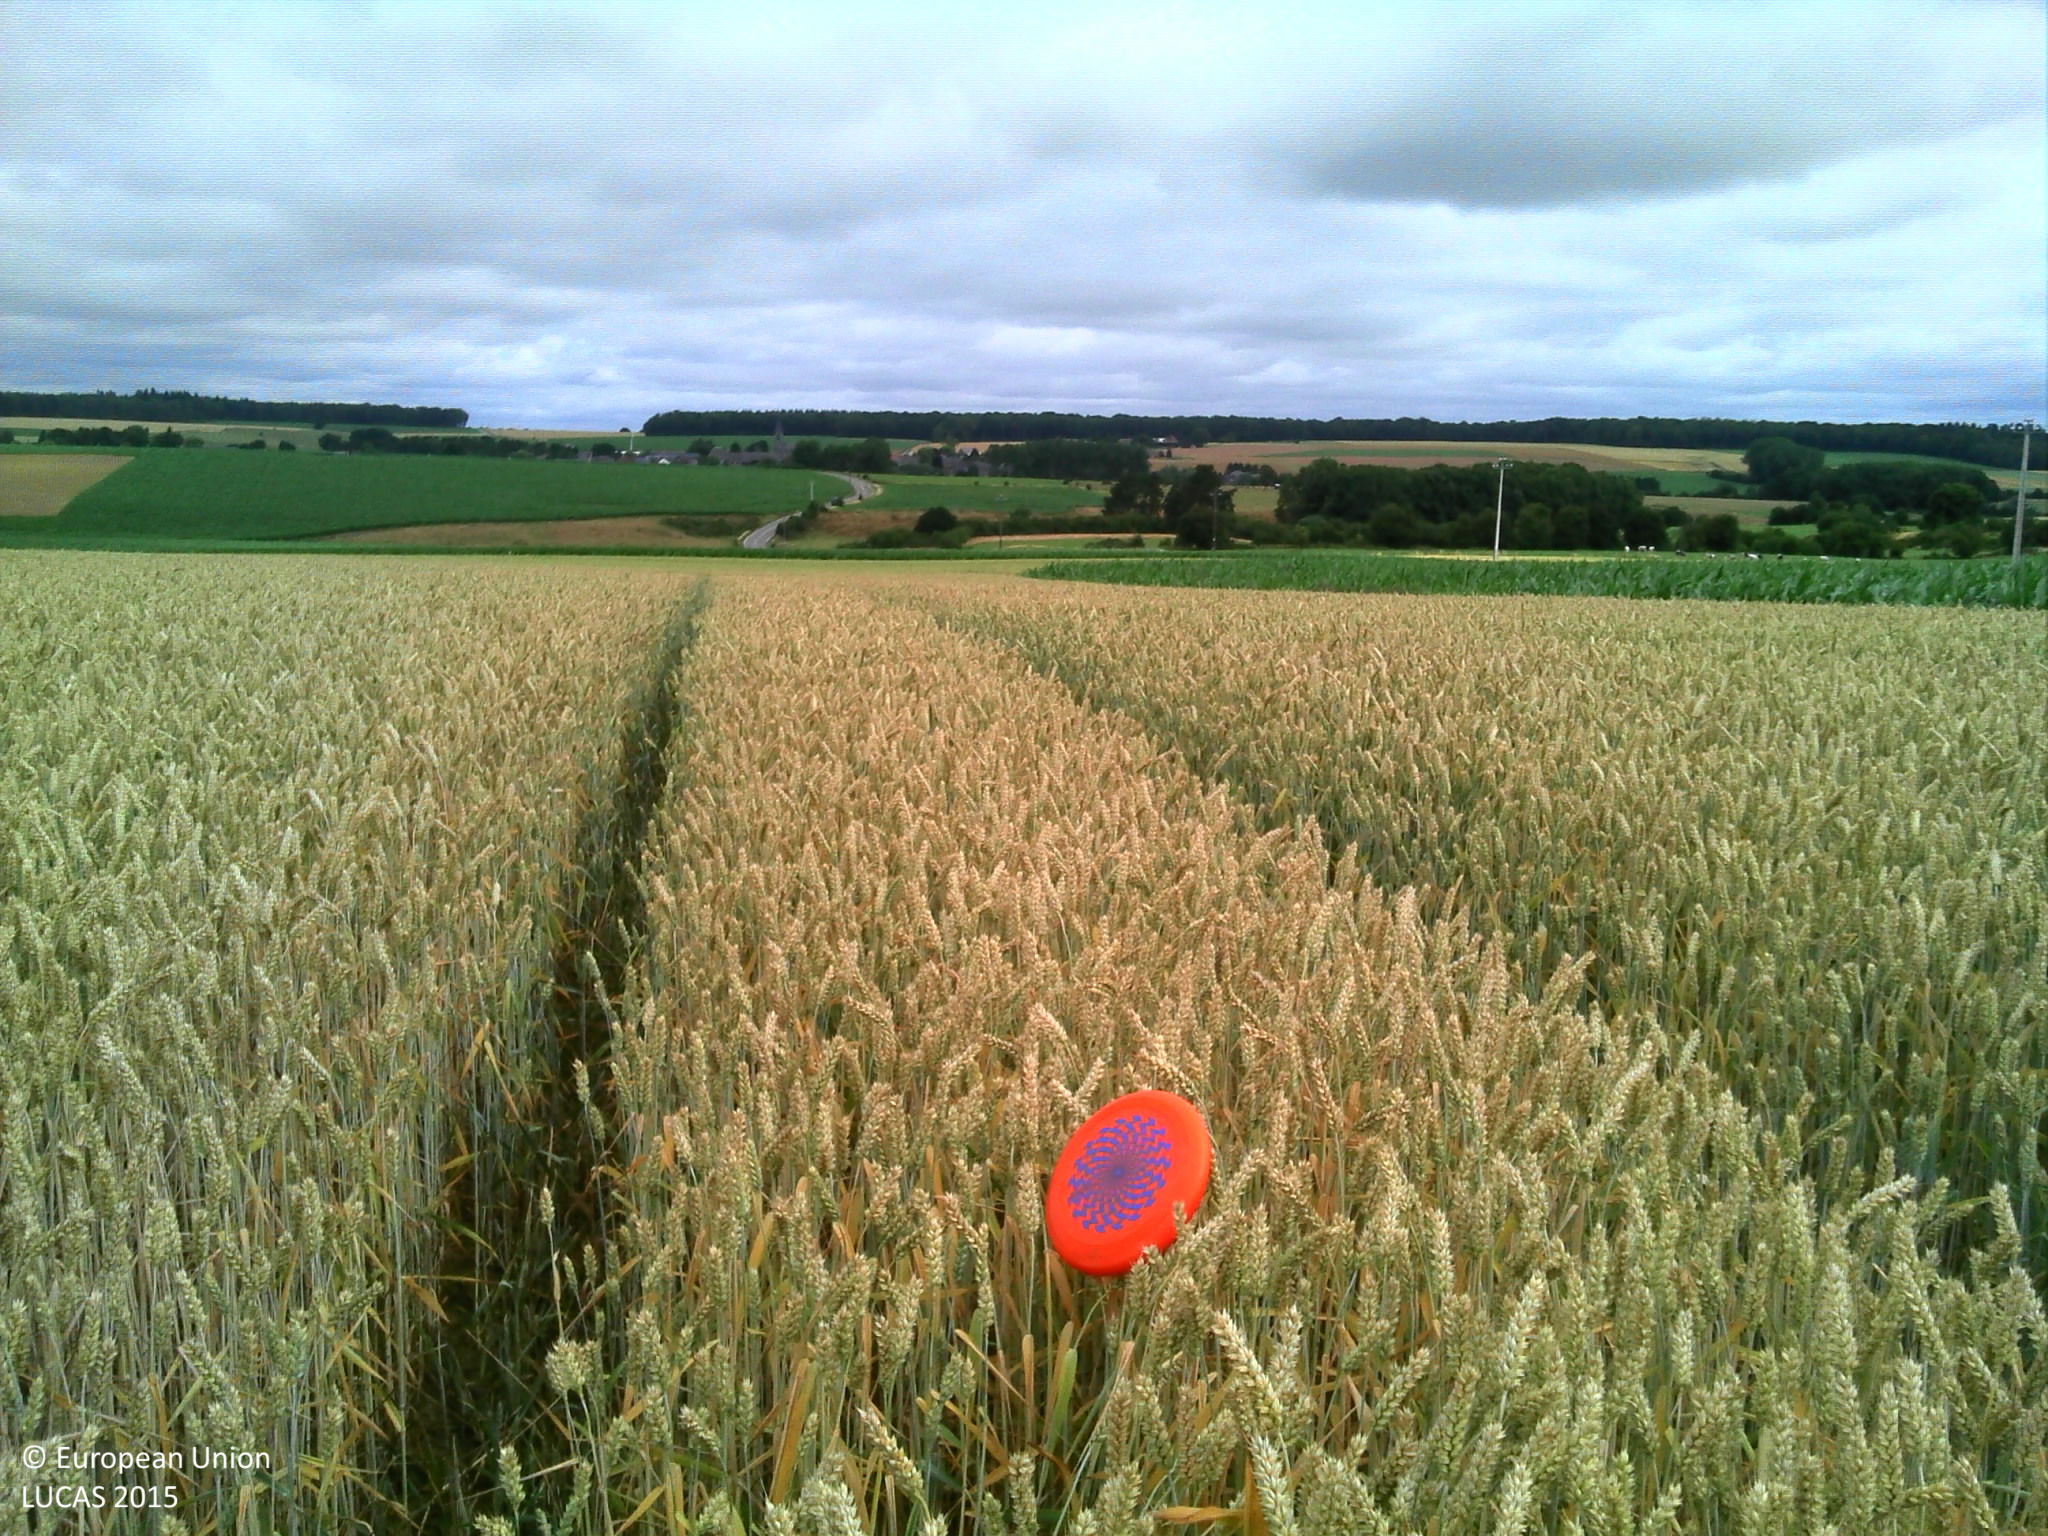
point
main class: Cropland
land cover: Common wheat
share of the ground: > 75 %
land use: Agriculture (excluding fallow land and kitchen gardens)
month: July
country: BE
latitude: 50.2404
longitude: 4.6823
